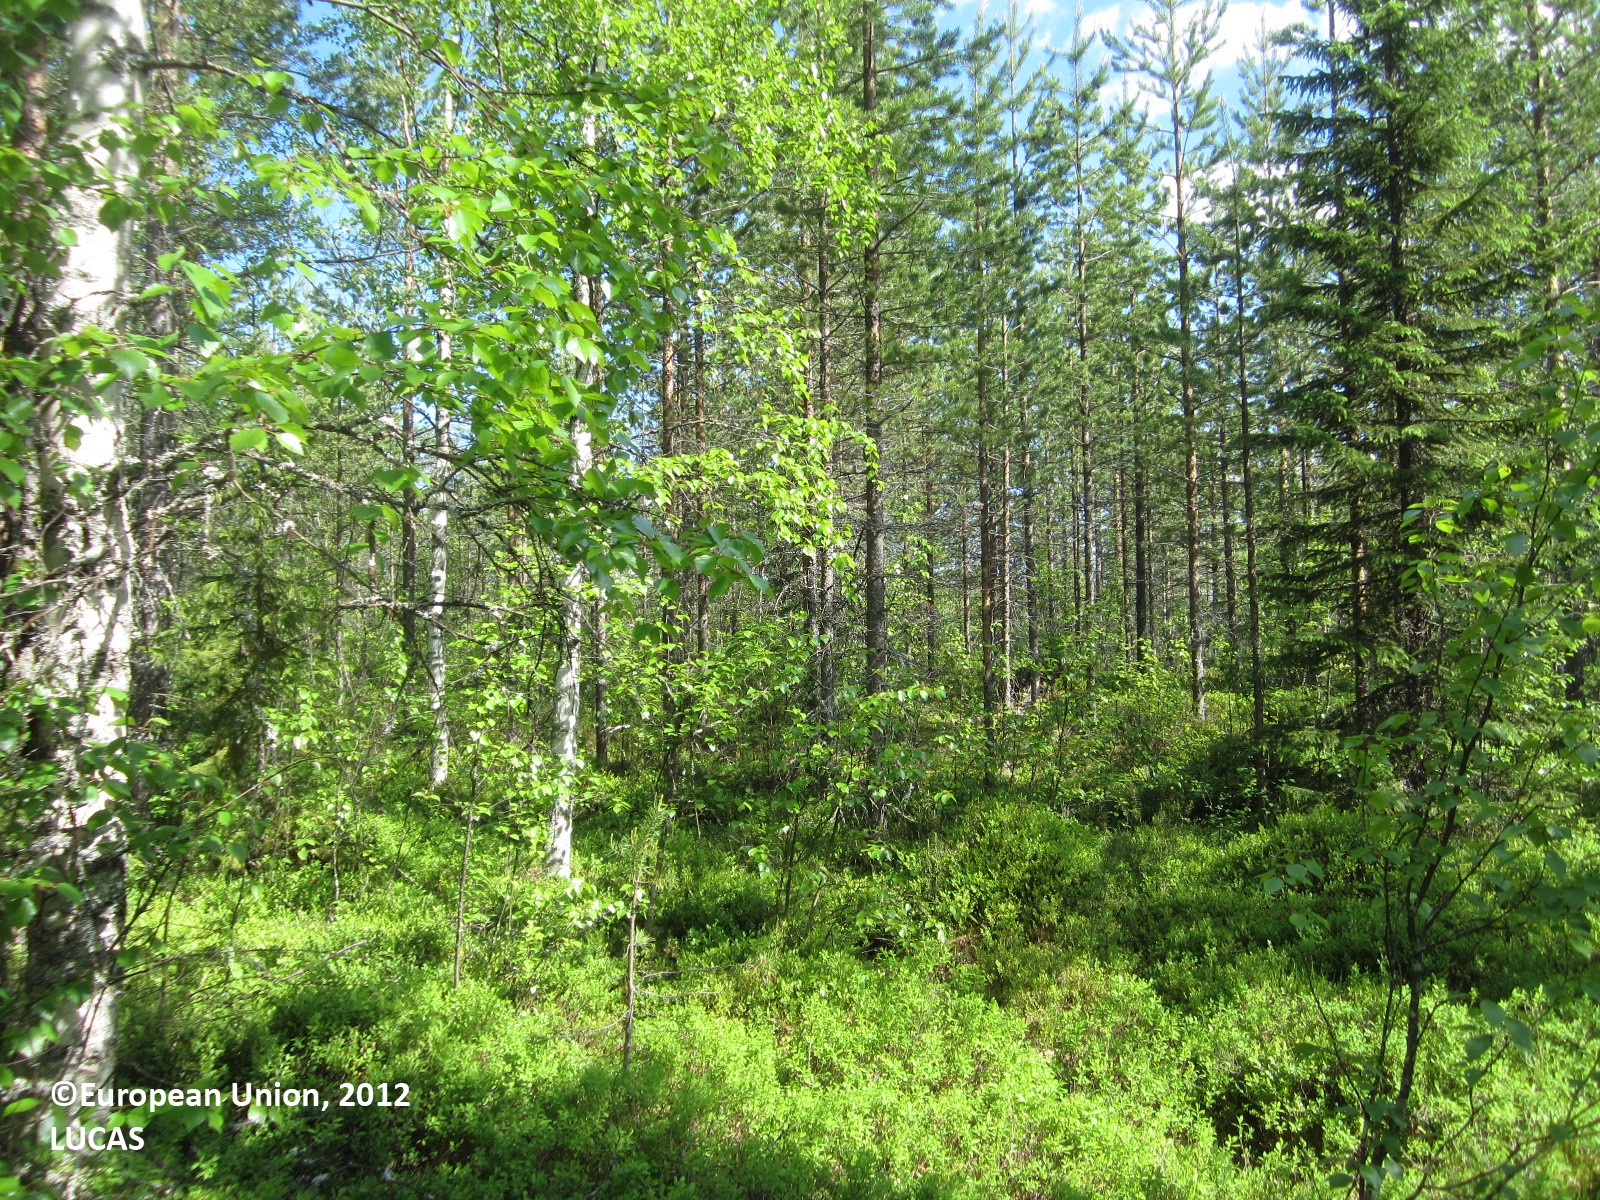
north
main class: Woodland
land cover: Pine dominated mixed woodland
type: boreal forest
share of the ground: 50 - 75 %
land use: Forestry
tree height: > 5 m
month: June
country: FI
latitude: 64.7977
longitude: 28.8975
